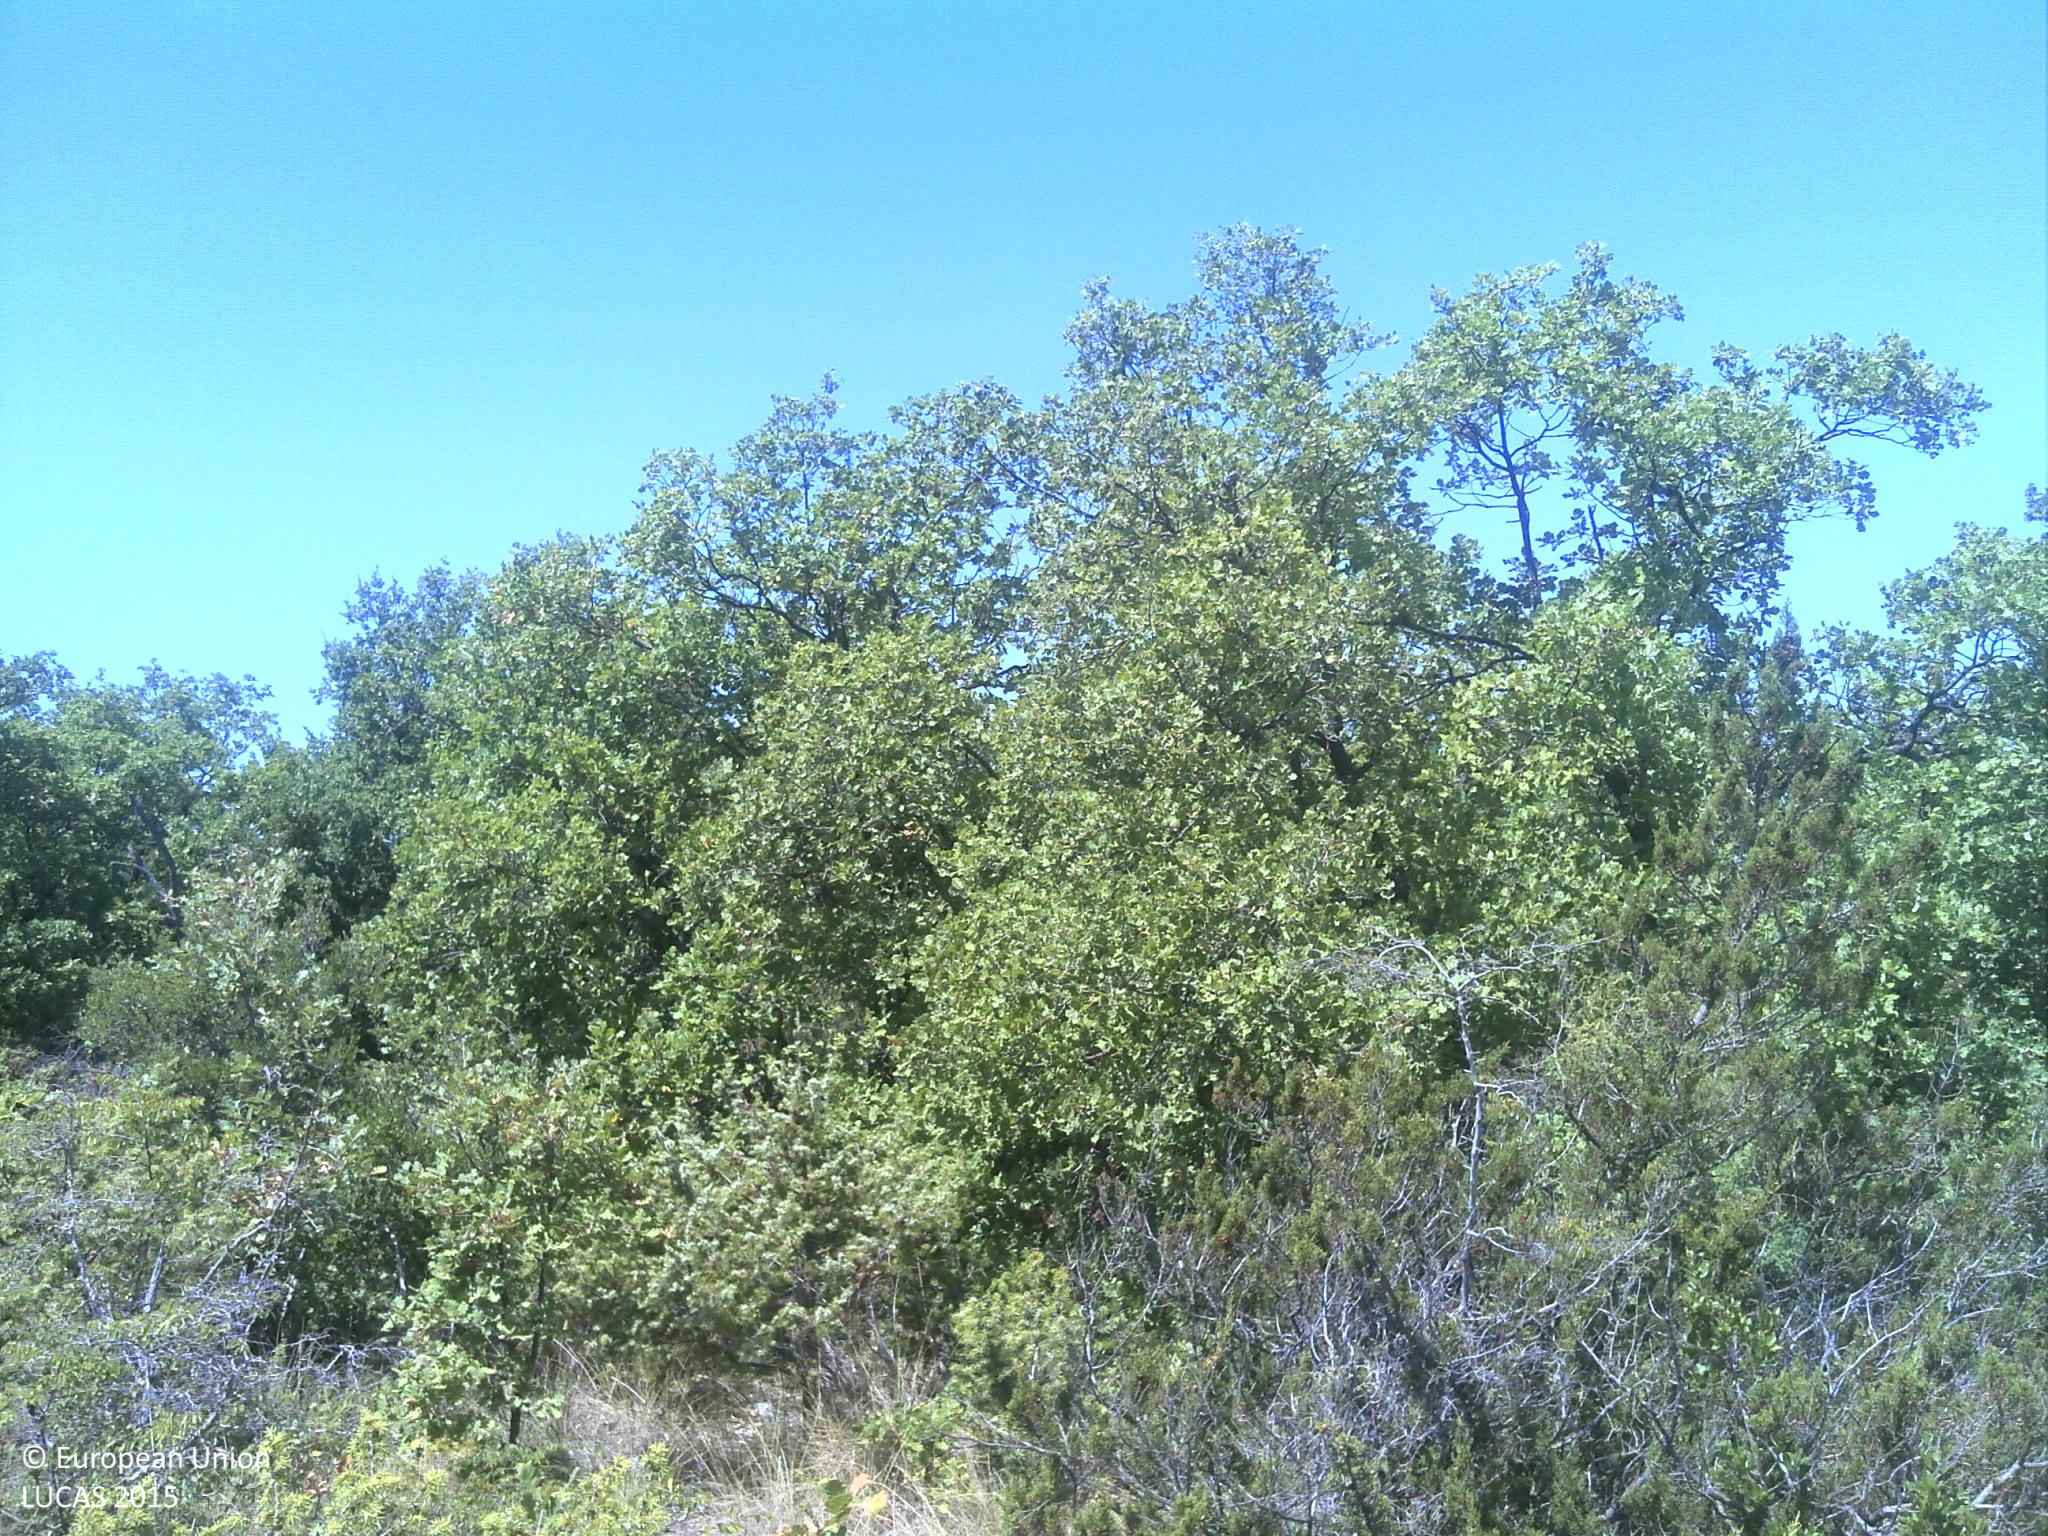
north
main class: Woodland
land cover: Broadleaved woodland
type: thermophilous deciduous forest
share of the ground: 25 - 50 %
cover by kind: shrubs 40 %, broadleaved forest trees 35 %, consolidated bare surface 10 %, unconsolidated bare surface 10 %, herbaceous plants 5 %
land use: Semi-natural and natural areas not in use
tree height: > 5 m
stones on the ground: > 50 %
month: August
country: HR
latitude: 43.8143
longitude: 15.6976
